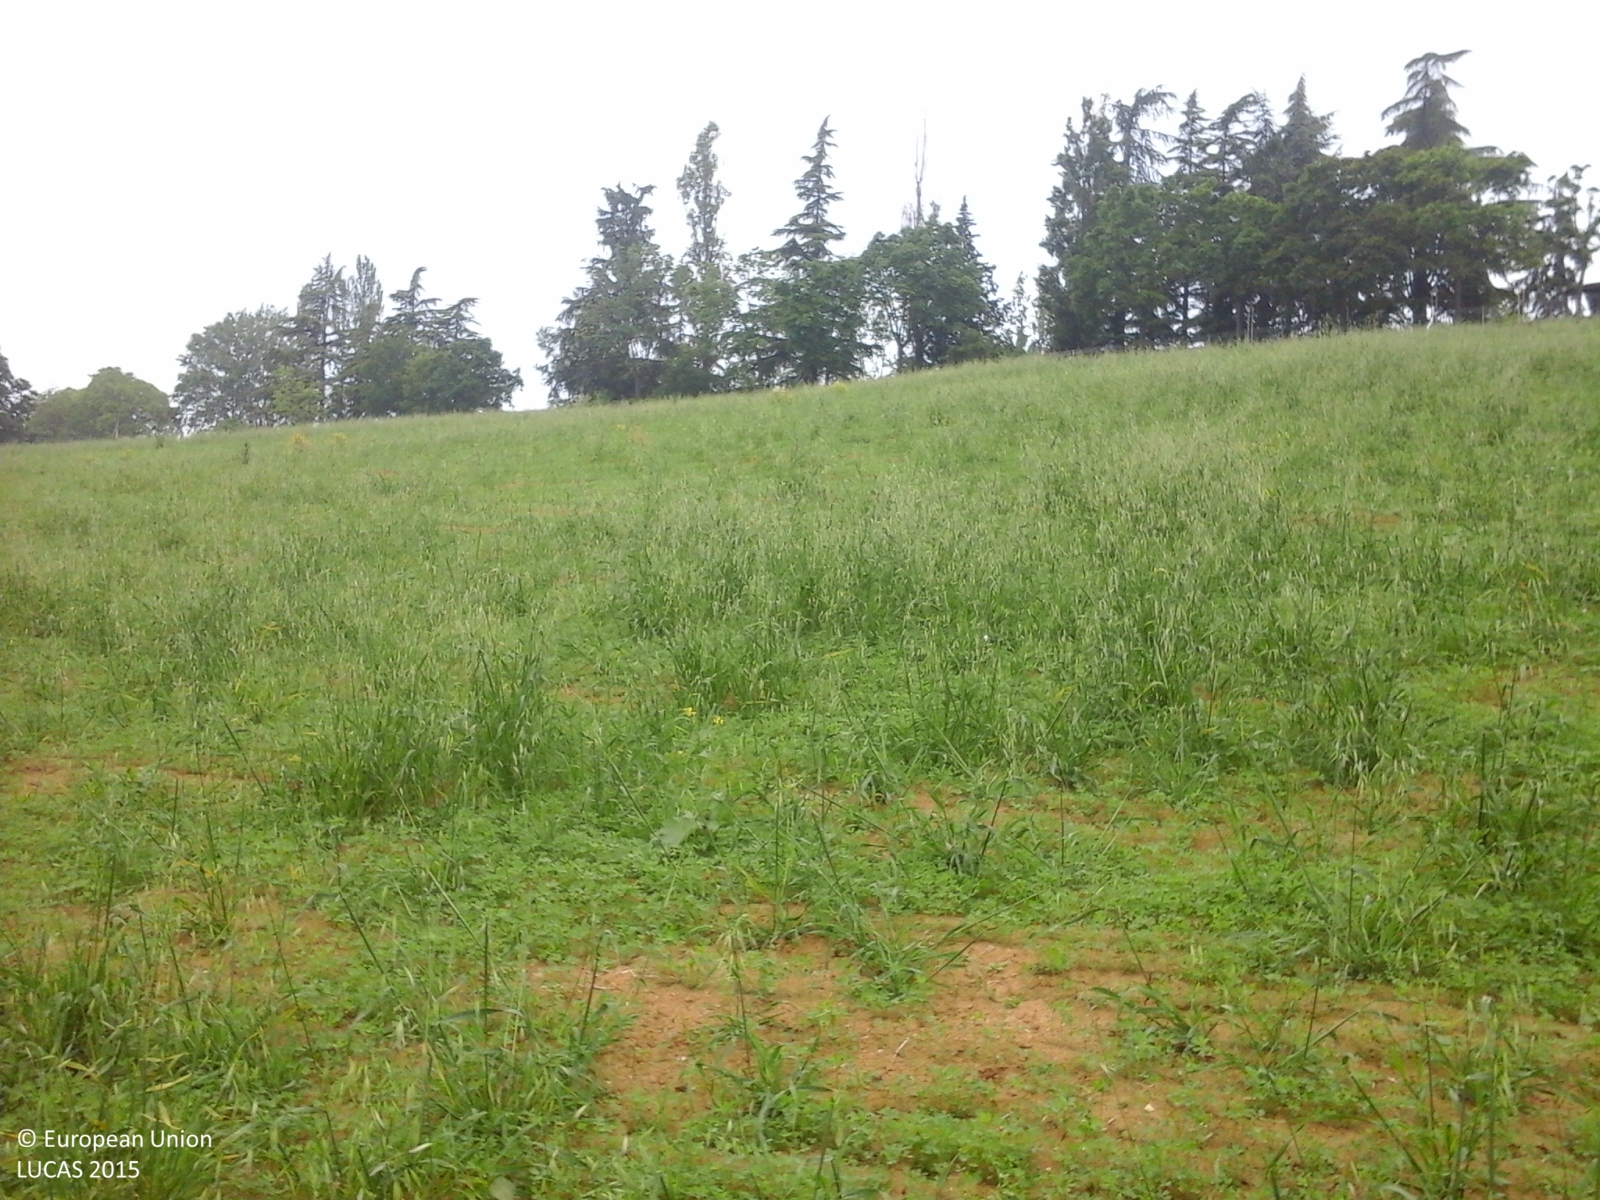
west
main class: Cropland
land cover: Lucerne
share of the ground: > 75 %
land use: Agriculture (excluding fallow land and kitchen gardens)
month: May
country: IT
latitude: 44.4723
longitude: 10.9658
